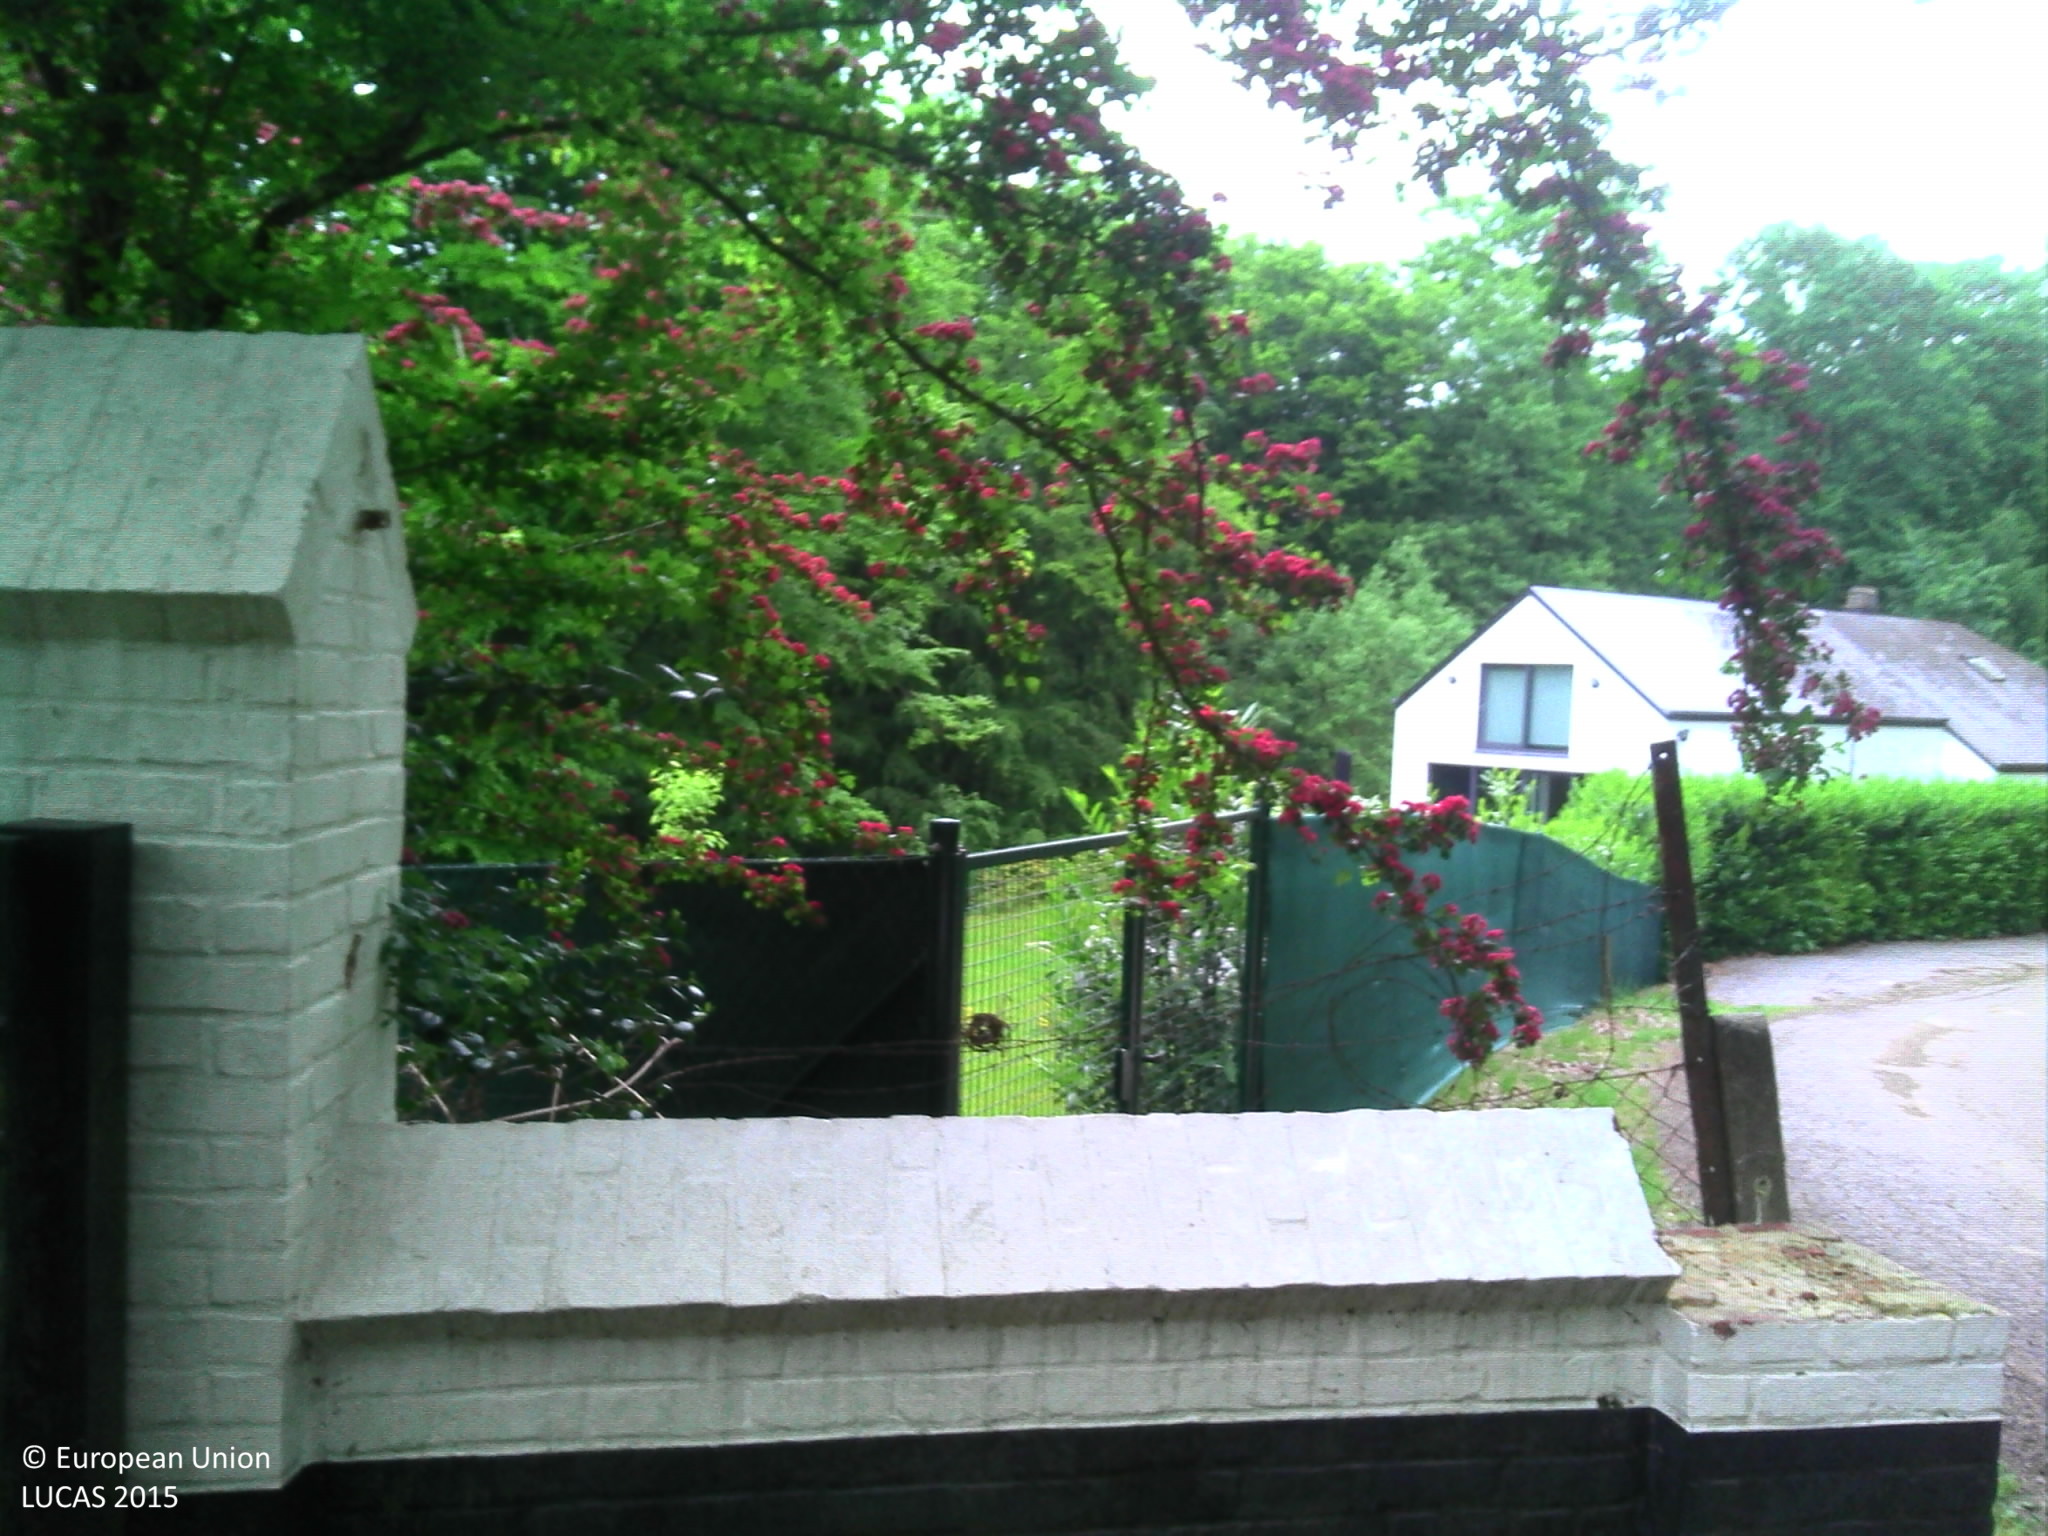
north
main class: Grassland
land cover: Grassland with sparse tree/shrub cover
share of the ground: > 75 %
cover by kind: herbaceous plants 95 %, broadleaved forest trees 5 %
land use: Residential
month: May
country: BE
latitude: 50.6872
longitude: 4.6032
